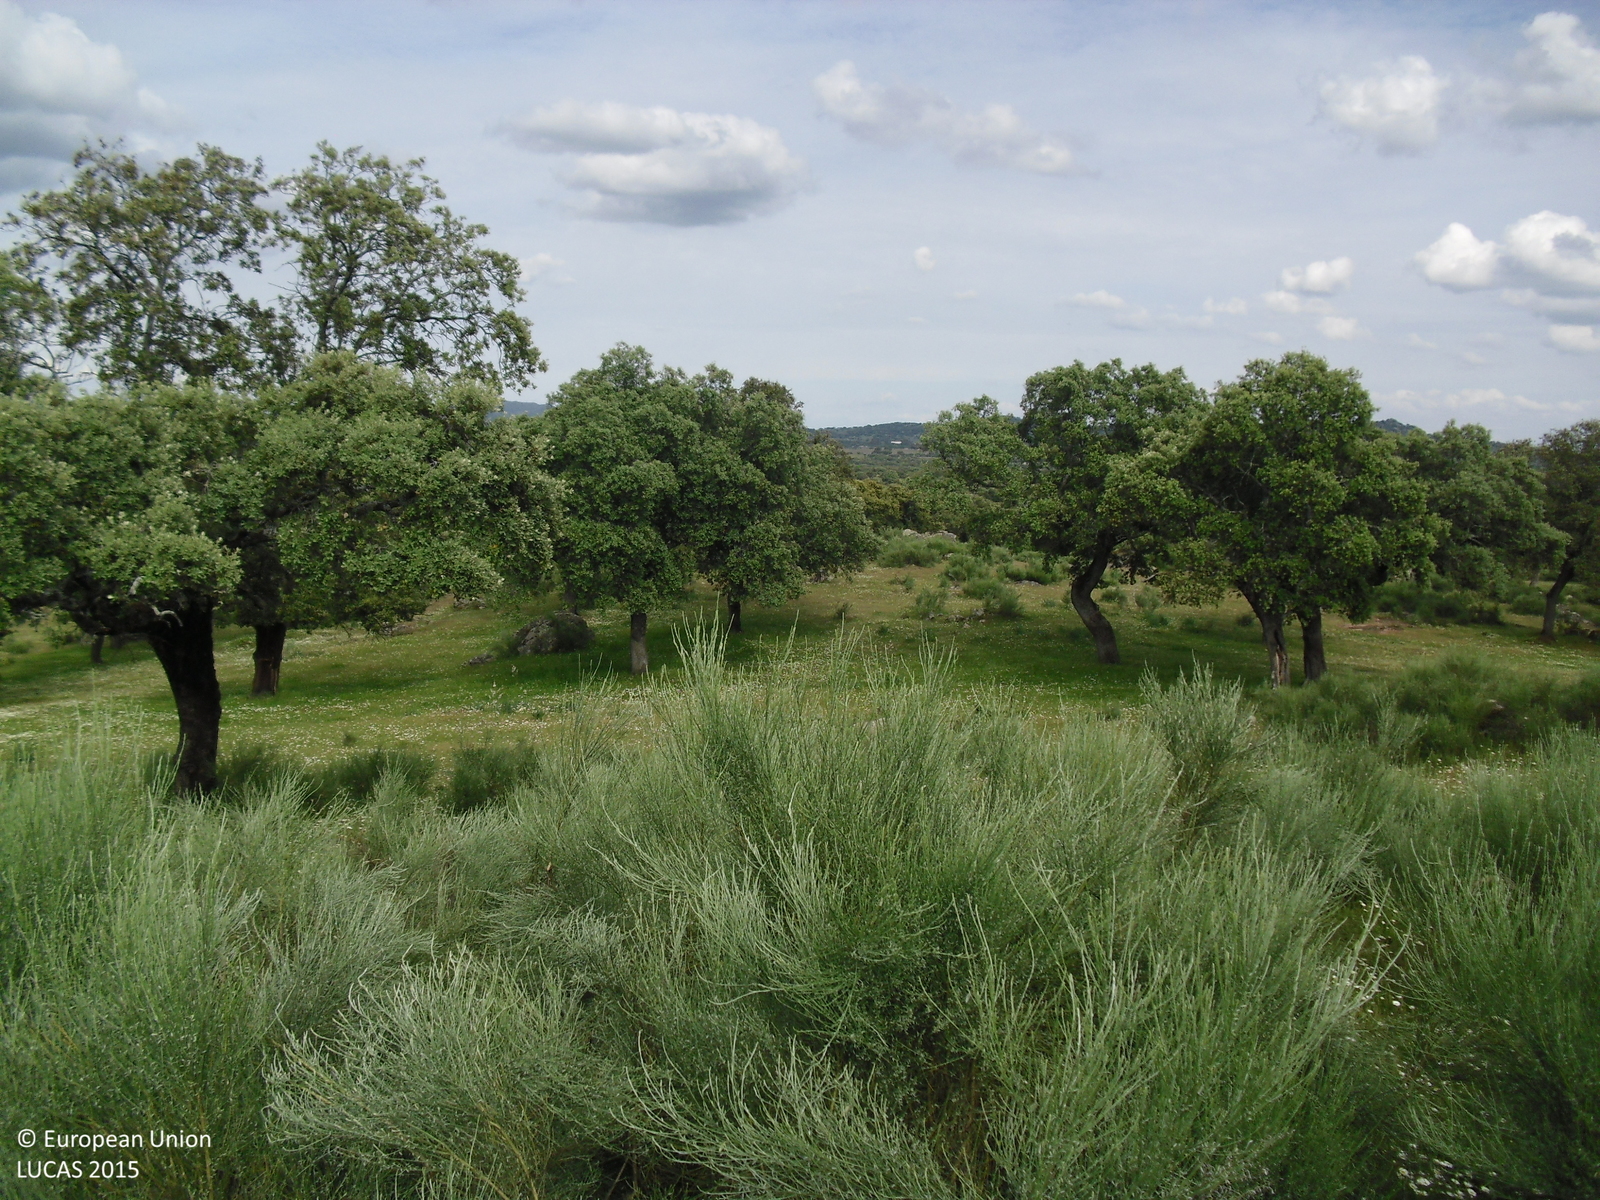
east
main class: Shrubland
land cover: Shrubland with sparse tree cover
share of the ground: > 75 %
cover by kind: shrubs 75 %, herbaceous plants 20 %, broadleaved forest trees 5 %
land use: Agriculture (excluding fallow land and kitchen gardens)
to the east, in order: Shrubland with sparse tree cover; Broadleaved woodland; Tracks; Broadleaved woodland; Tracks; Broadleaved woodland
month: April
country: ES
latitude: 39.2942
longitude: -6.0005
